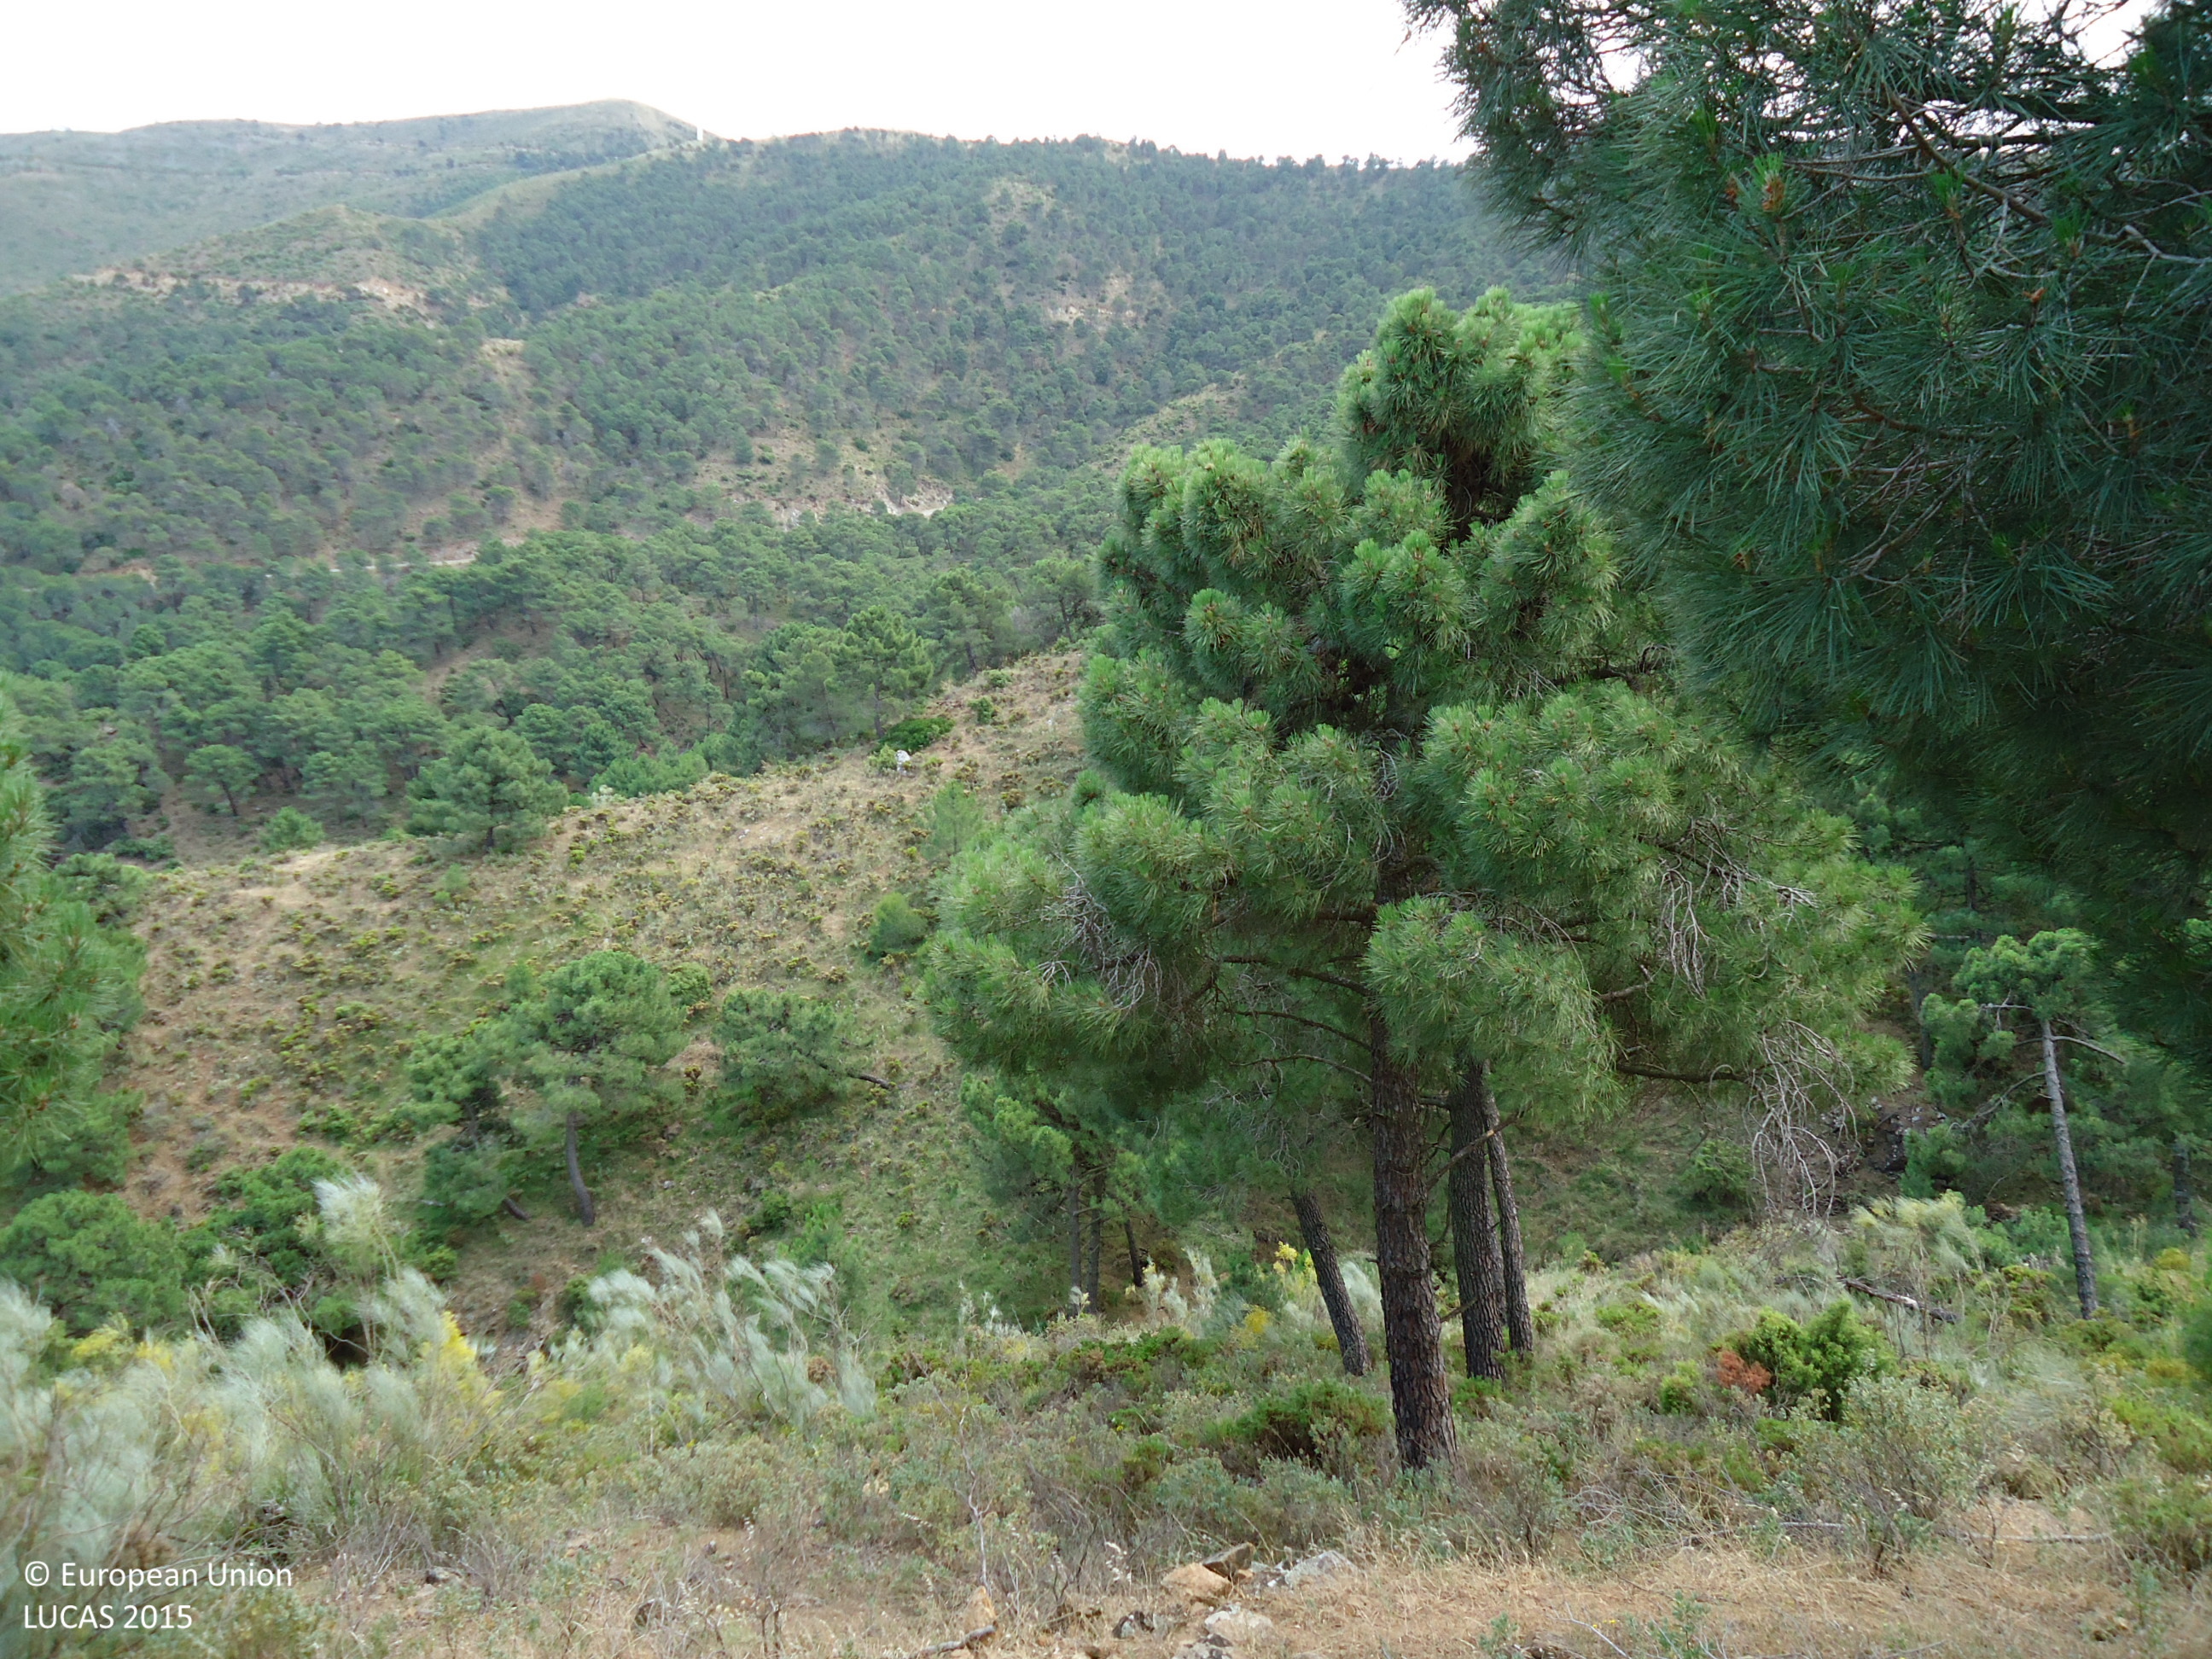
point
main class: Woodland
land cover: Pine dominated coniferous woodland
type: coniferous forest of the mediterranean region
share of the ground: 25 - 50 %
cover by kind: shrubs 75 %, coniferous forest trees 25 %
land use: Forestry
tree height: > 5 m
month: June
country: ES
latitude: 36.8600
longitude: -4.7912
